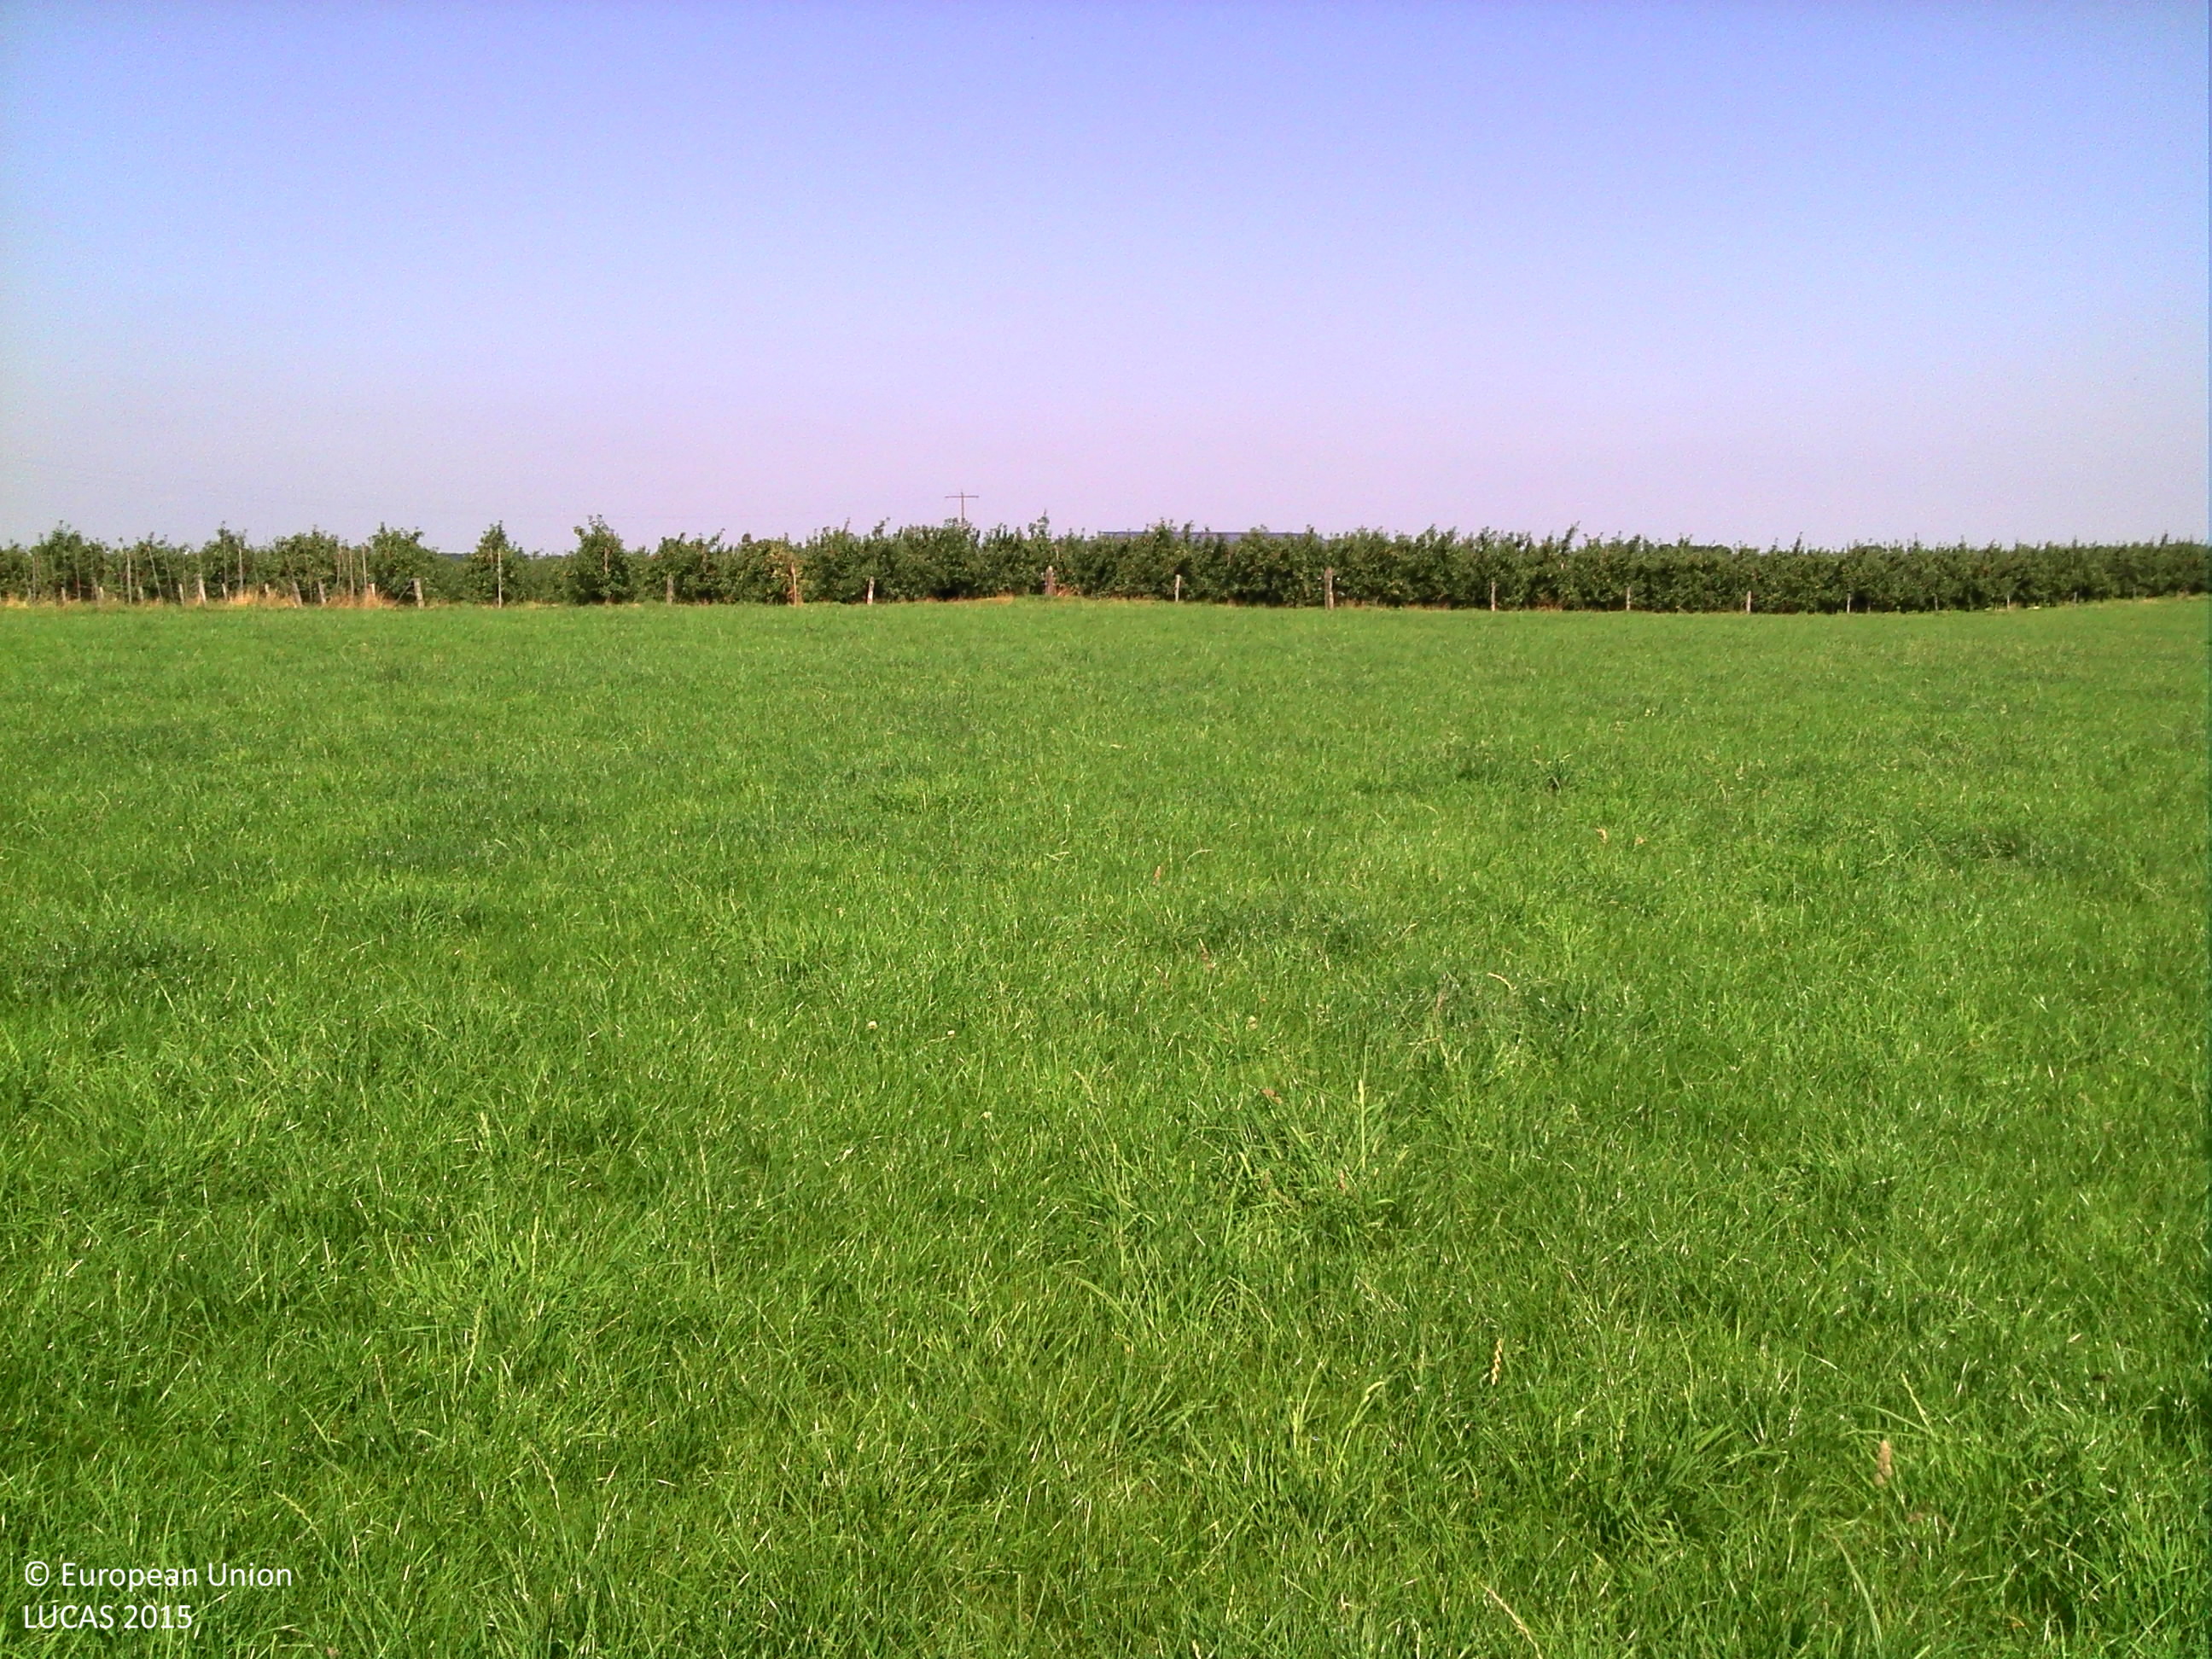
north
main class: Cropland
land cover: Temporary grasslands
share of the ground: > 75 %
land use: Agriculture (excluding fallow land and kitchen gardens)
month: August
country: BE
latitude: 50.7567
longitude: 5.8453
